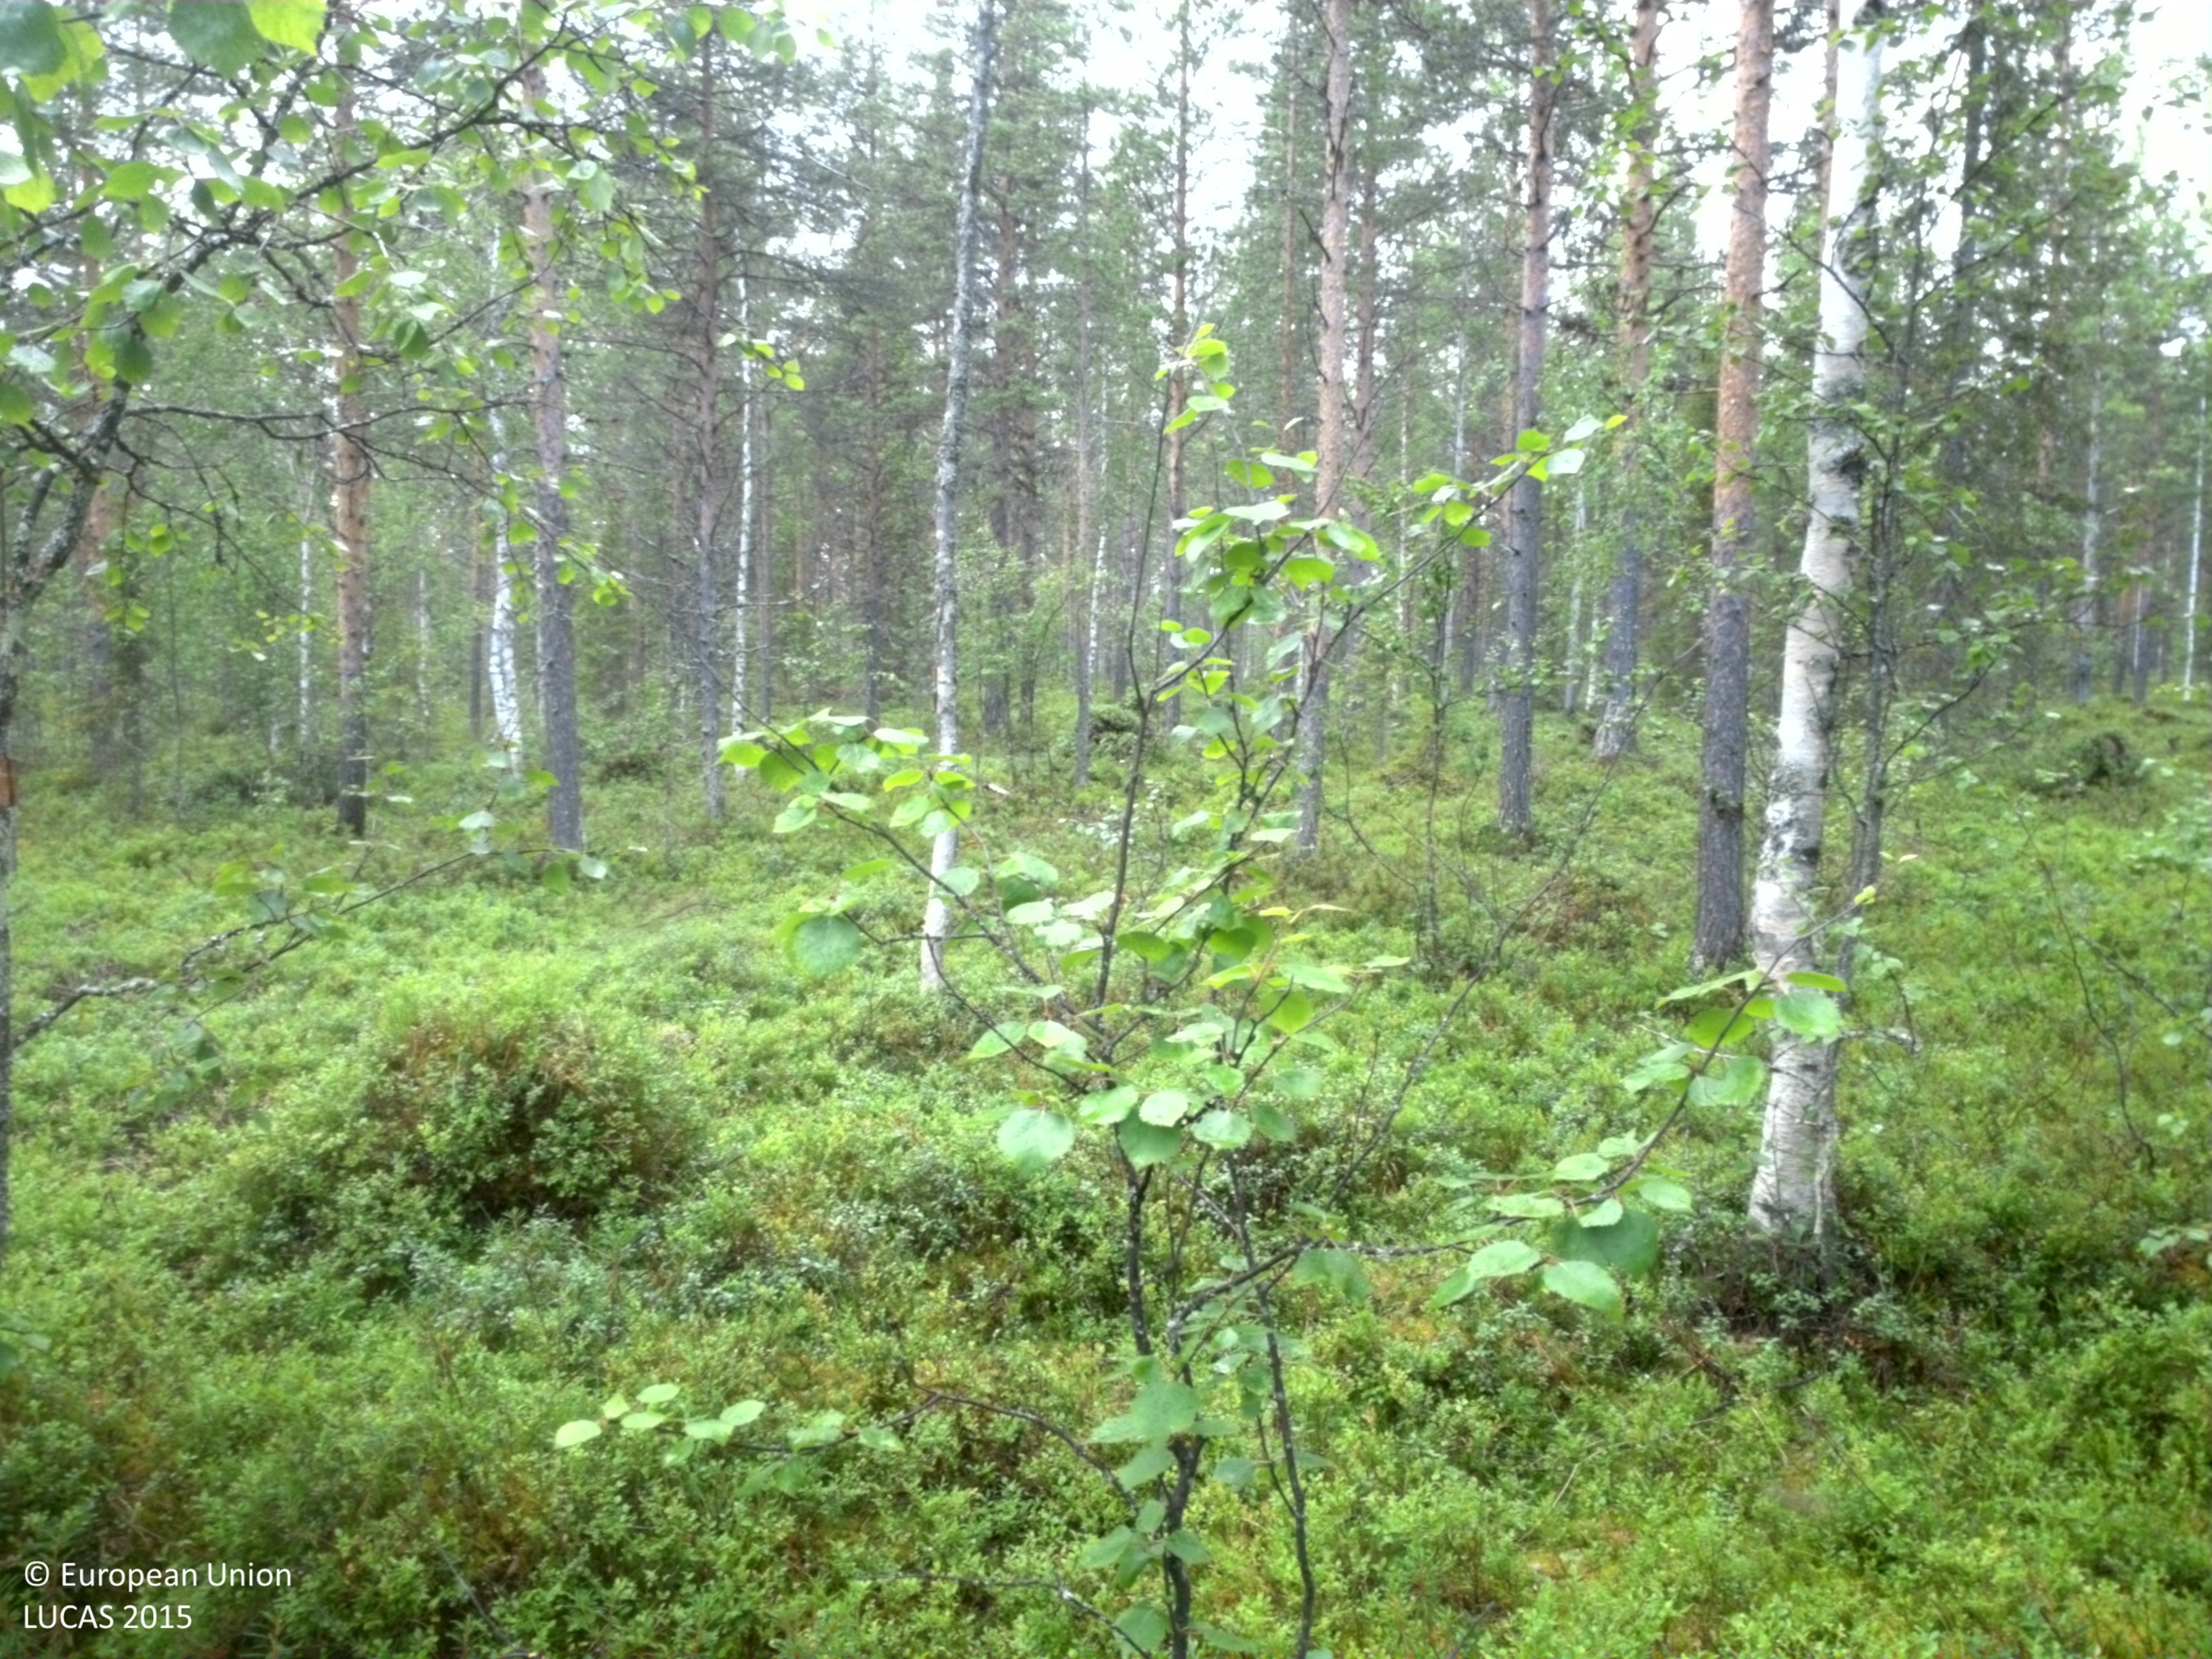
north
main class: Woodland
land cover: Pine dominated coniferous woodland
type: boreal forest
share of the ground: 25 - 50 %
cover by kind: shrubs 60 %, coniferous forest trees 30 %, broadleaved forest trees 5 %, lichens and mosses 5 %
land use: Forestry
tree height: > 5 m
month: July
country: SE
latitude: 66.1532
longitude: 20.4444
